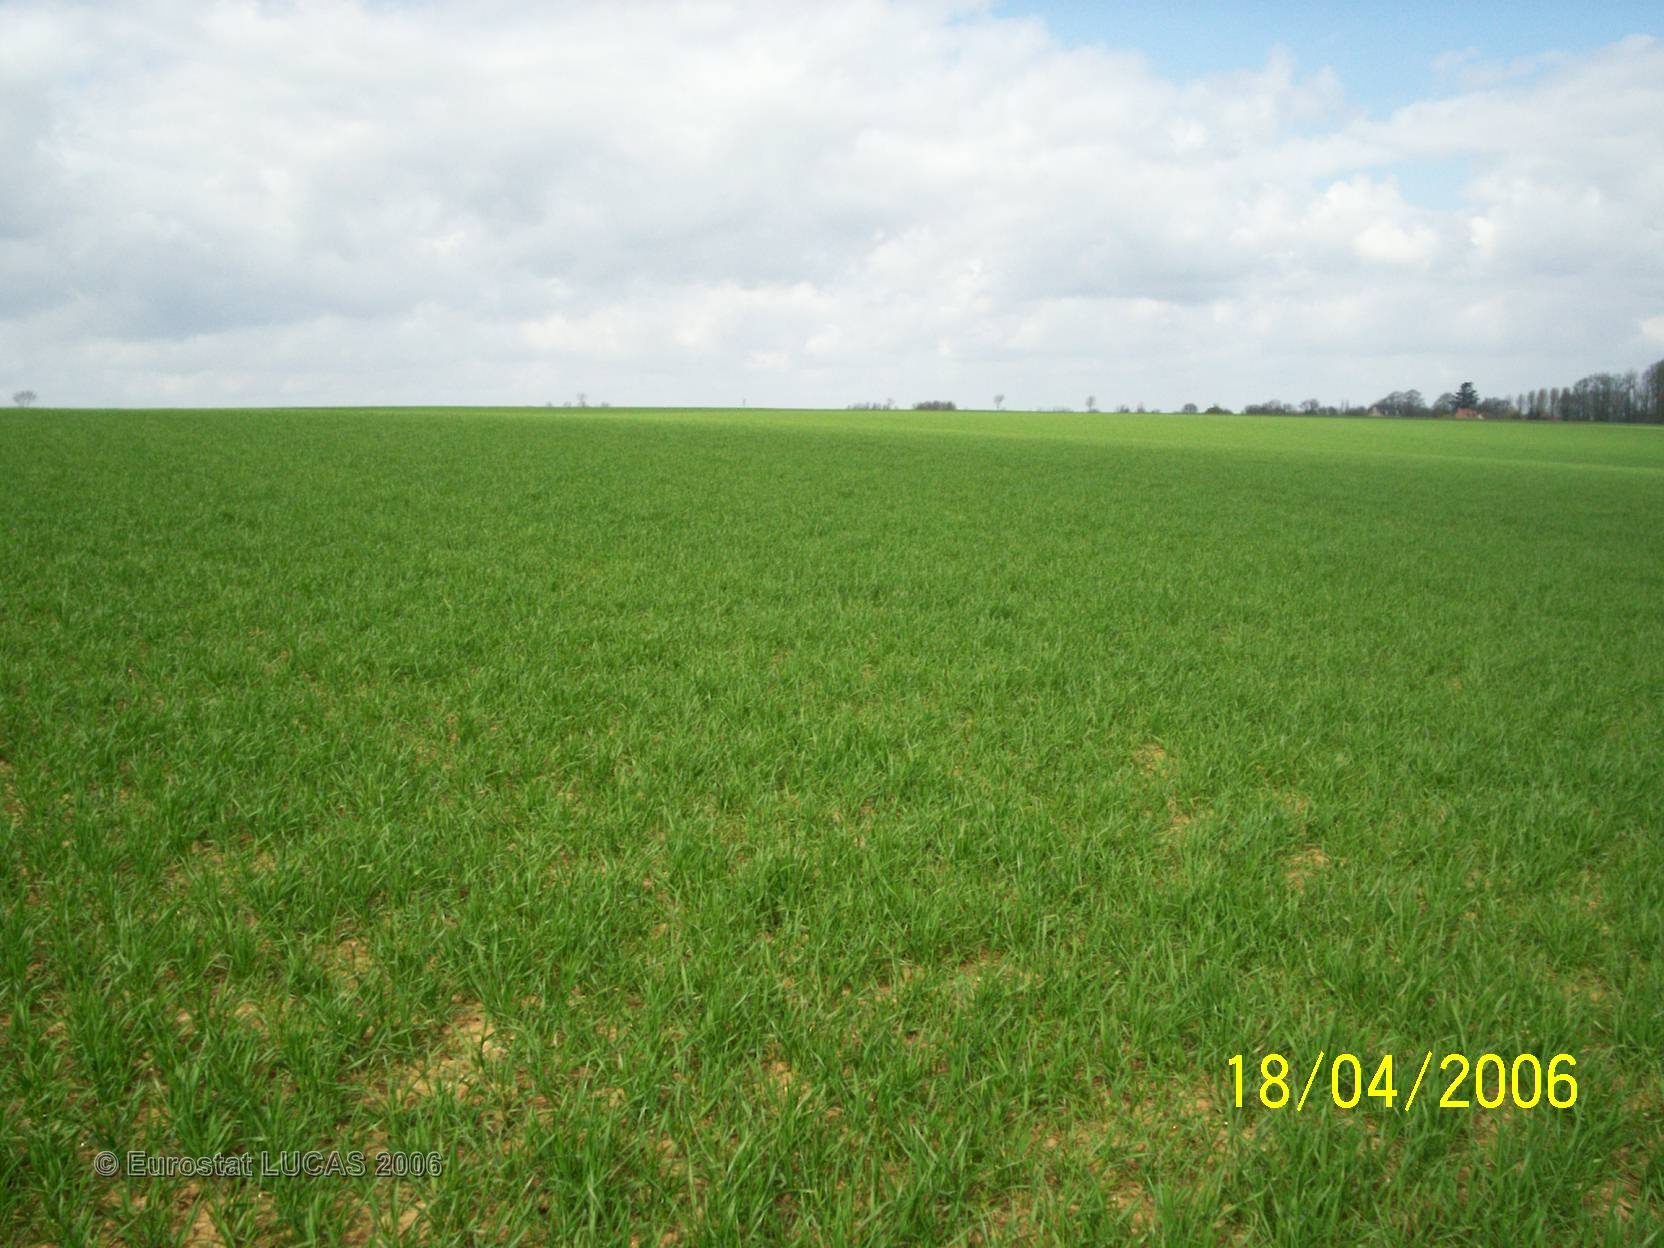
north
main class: Cropland
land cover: Common wheat
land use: Agriculture (excluding fallow land and kitchen gardens)
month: April
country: FR
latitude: 50.3362
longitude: 2.5272
